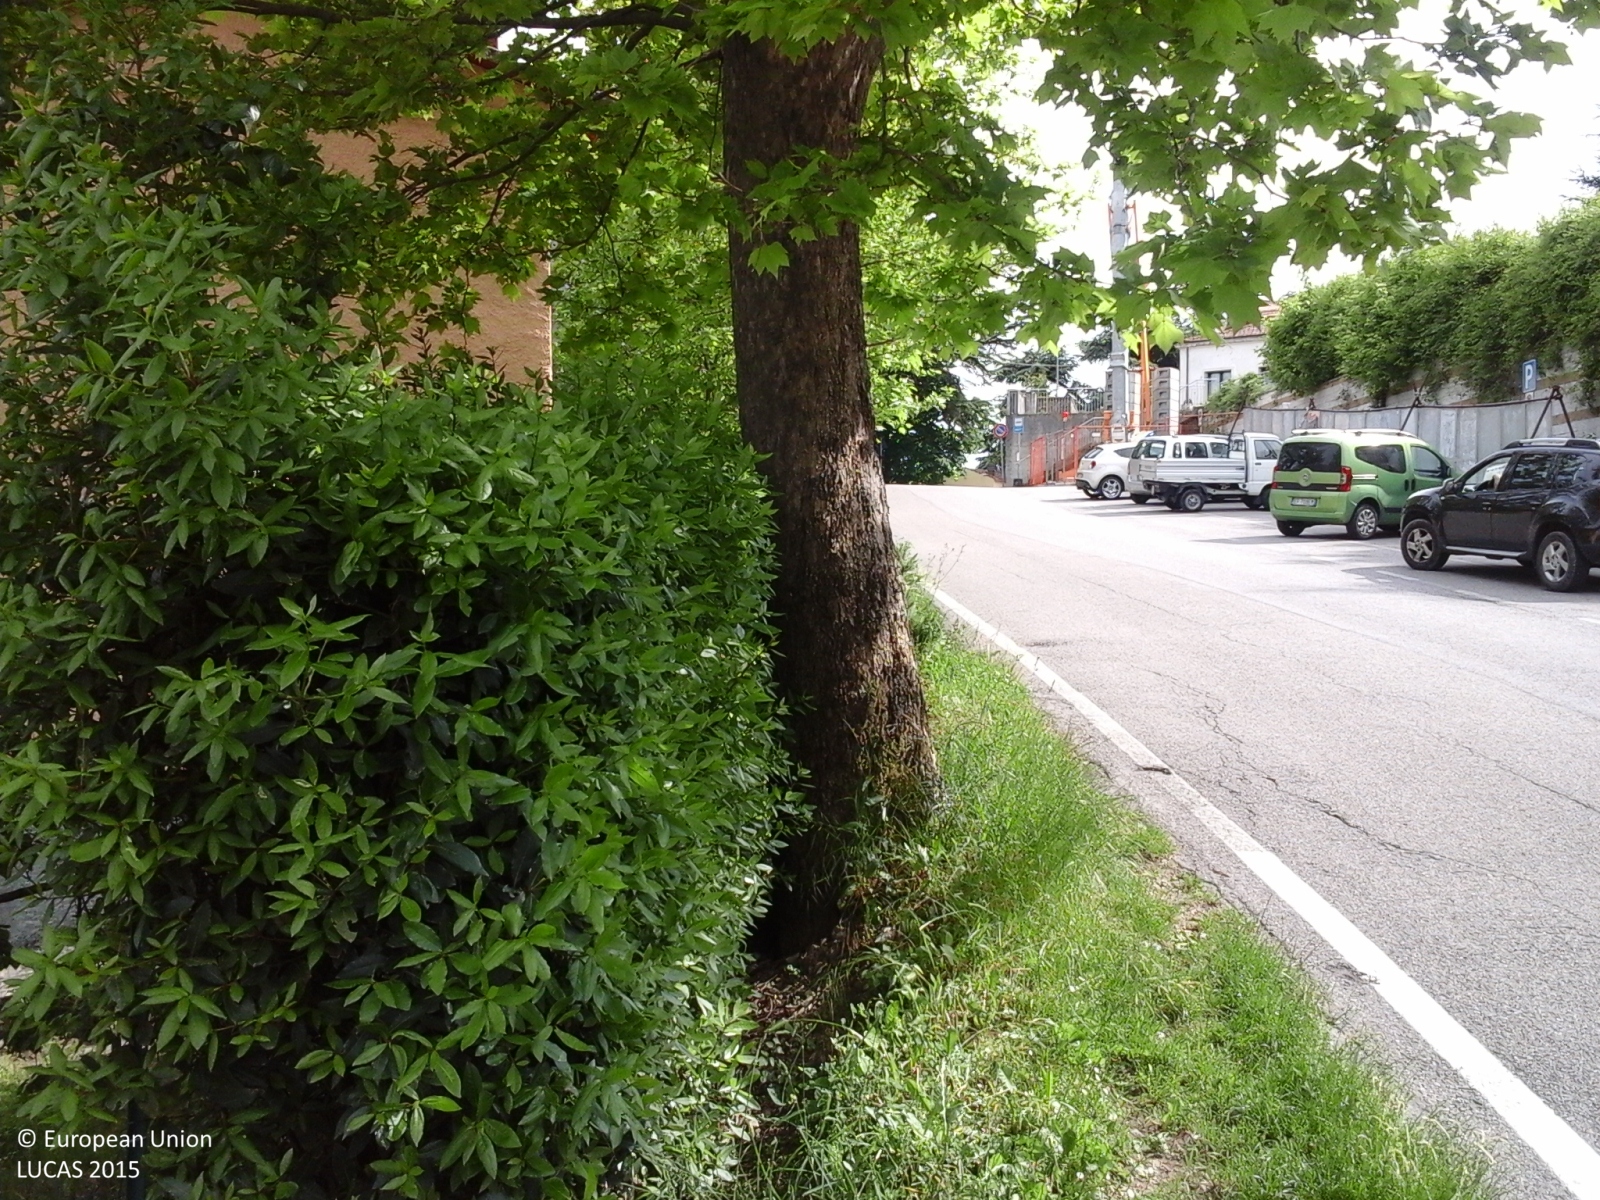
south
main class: Grassland
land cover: Grassland without tree/shrub cover
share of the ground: 10 - 25 %
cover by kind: herbaceous plants 100 %
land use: Residential
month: May
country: IT
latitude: 43.9658
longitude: 11.1065
